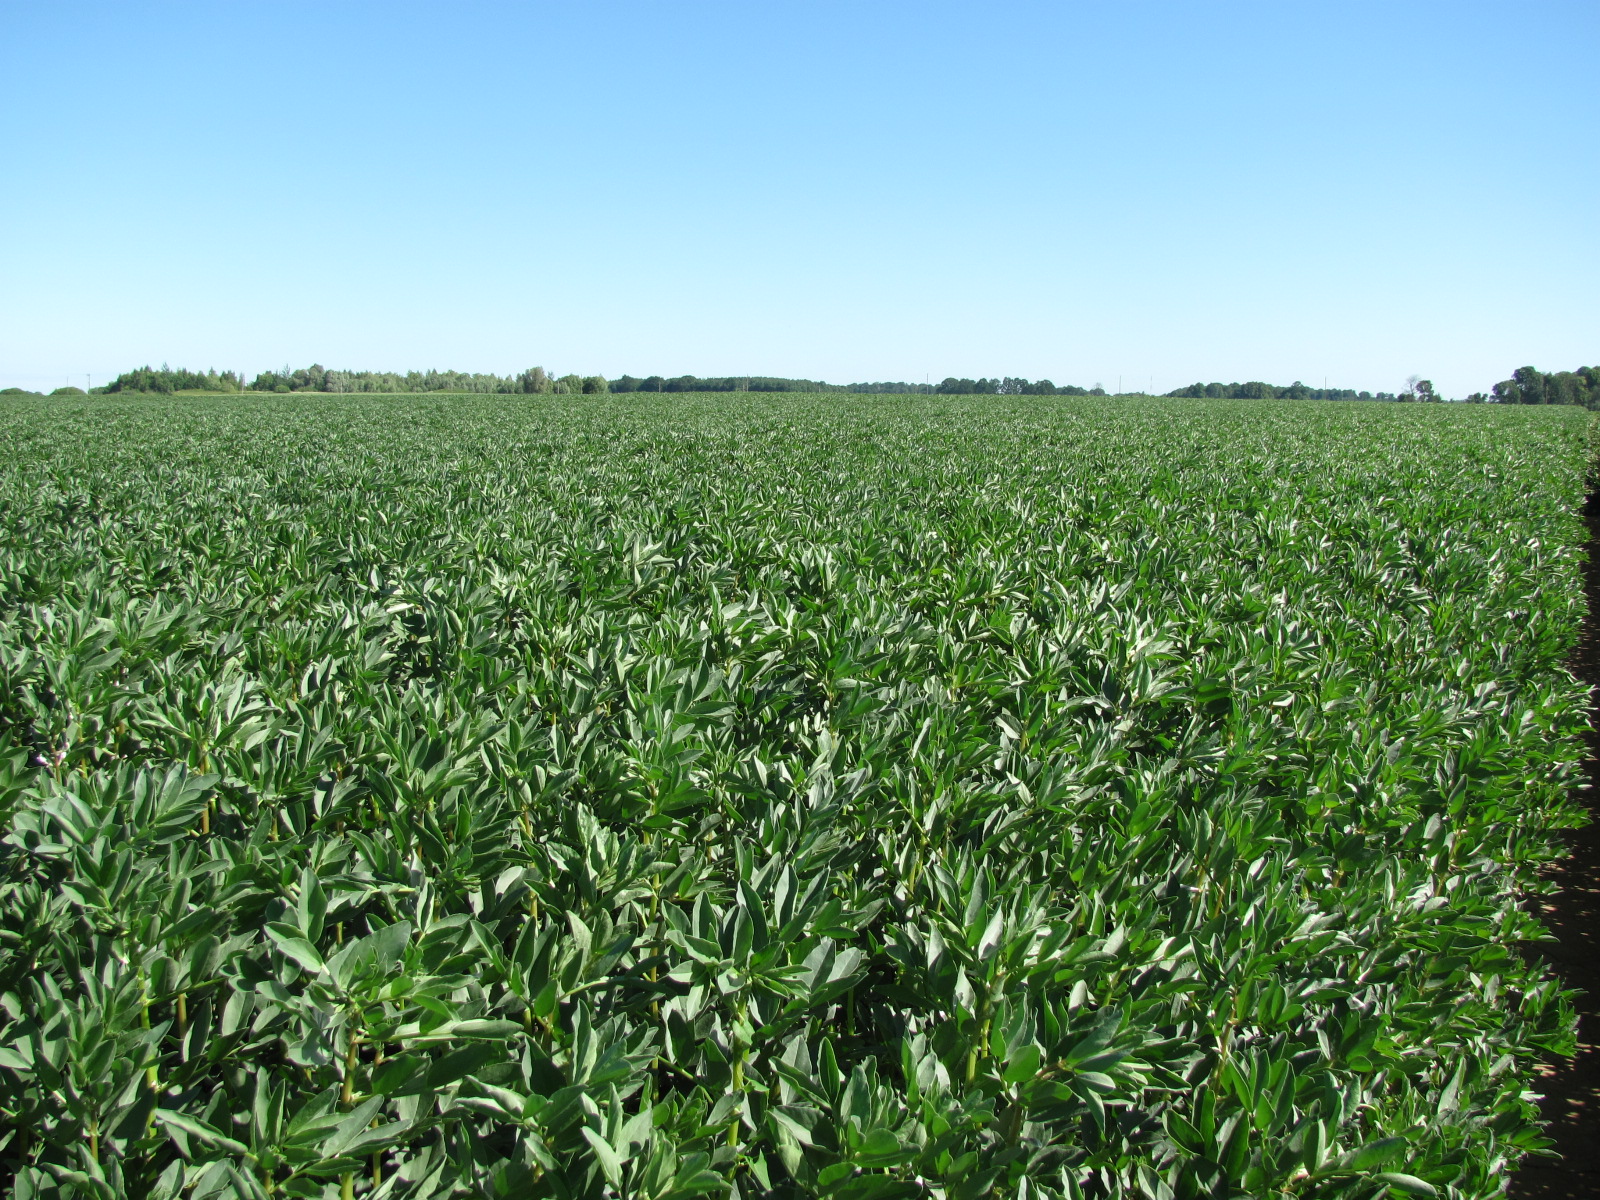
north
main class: Cropland
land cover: Dry pulses
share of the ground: > 75 %
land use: Agriculture (excluding fallow land and kitchen gardens)
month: July
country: LV
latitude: 56.4685
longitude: 23.8964
